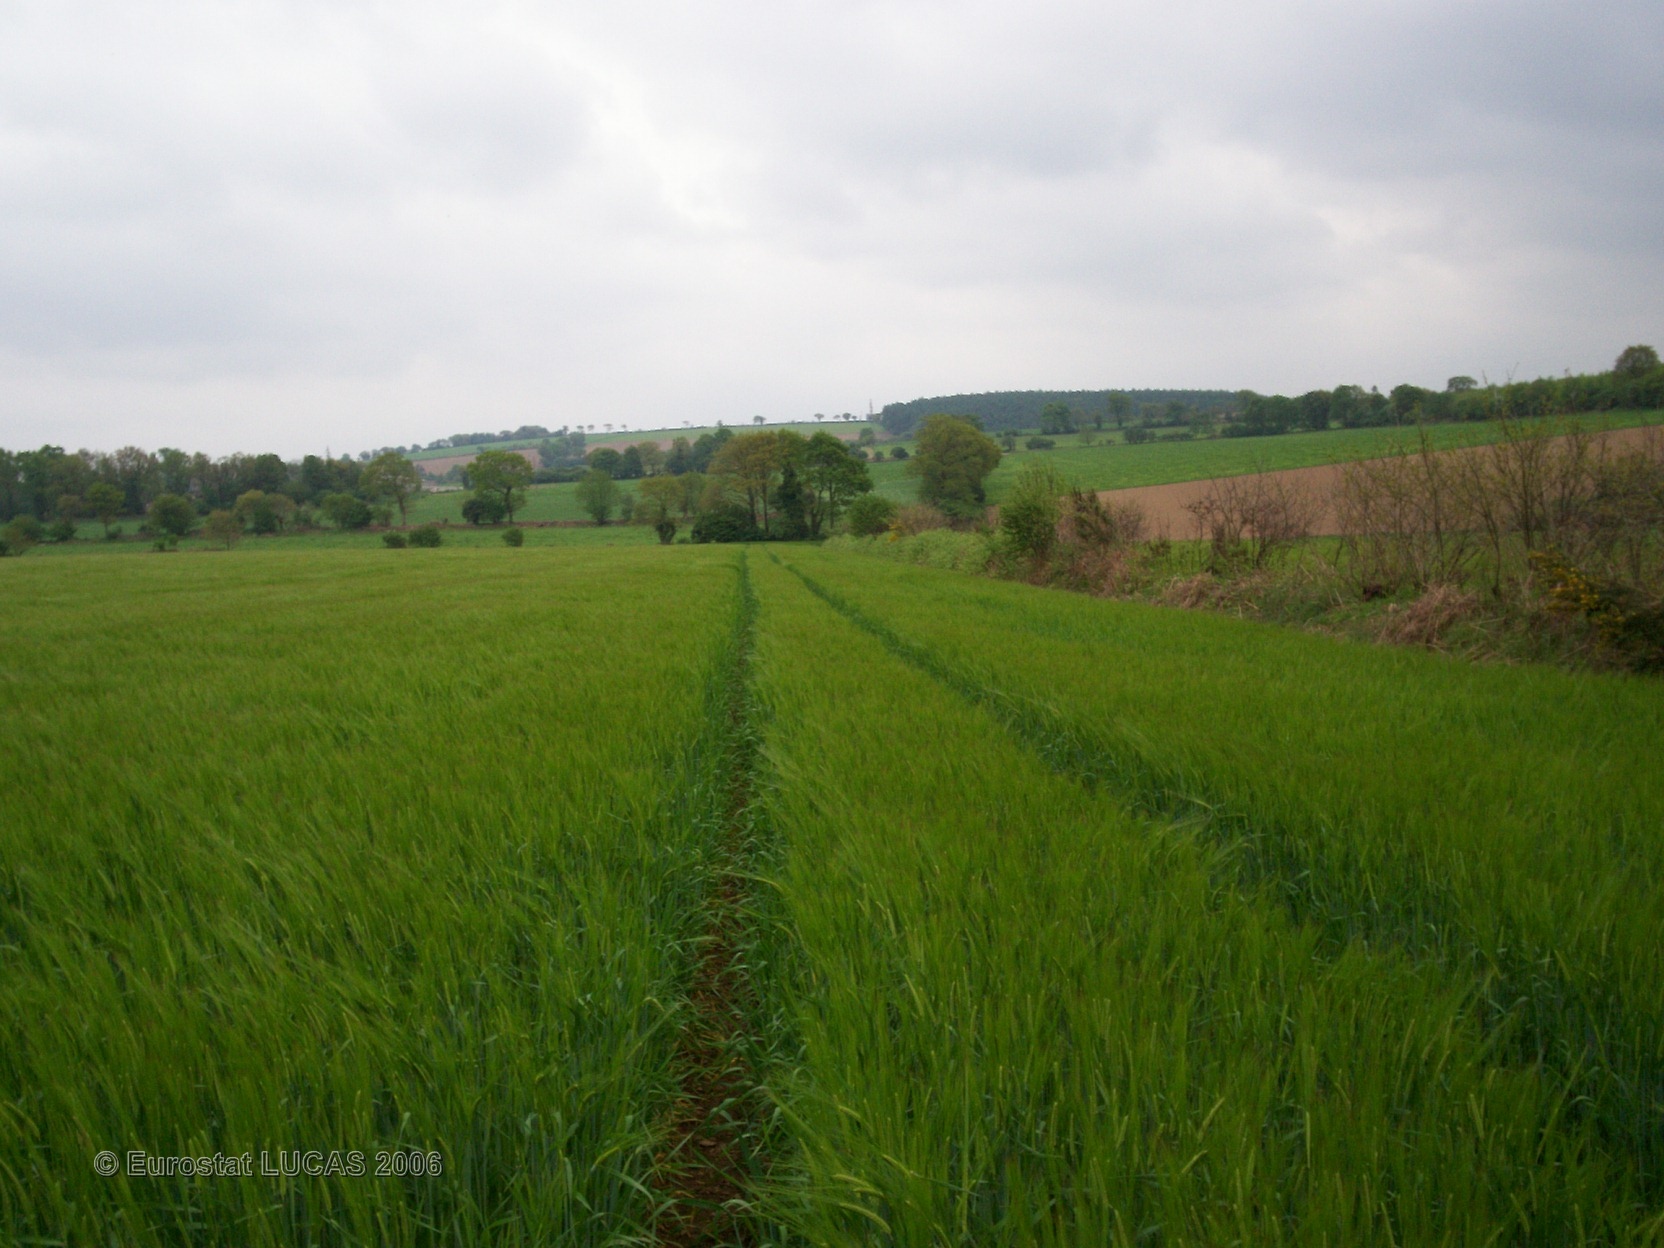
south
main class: Cropland
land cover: Barley
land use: Agriculture (excluding fallow land and kitchen gardens)
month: May
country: FR
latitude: 48.2575
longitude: -3.6994
